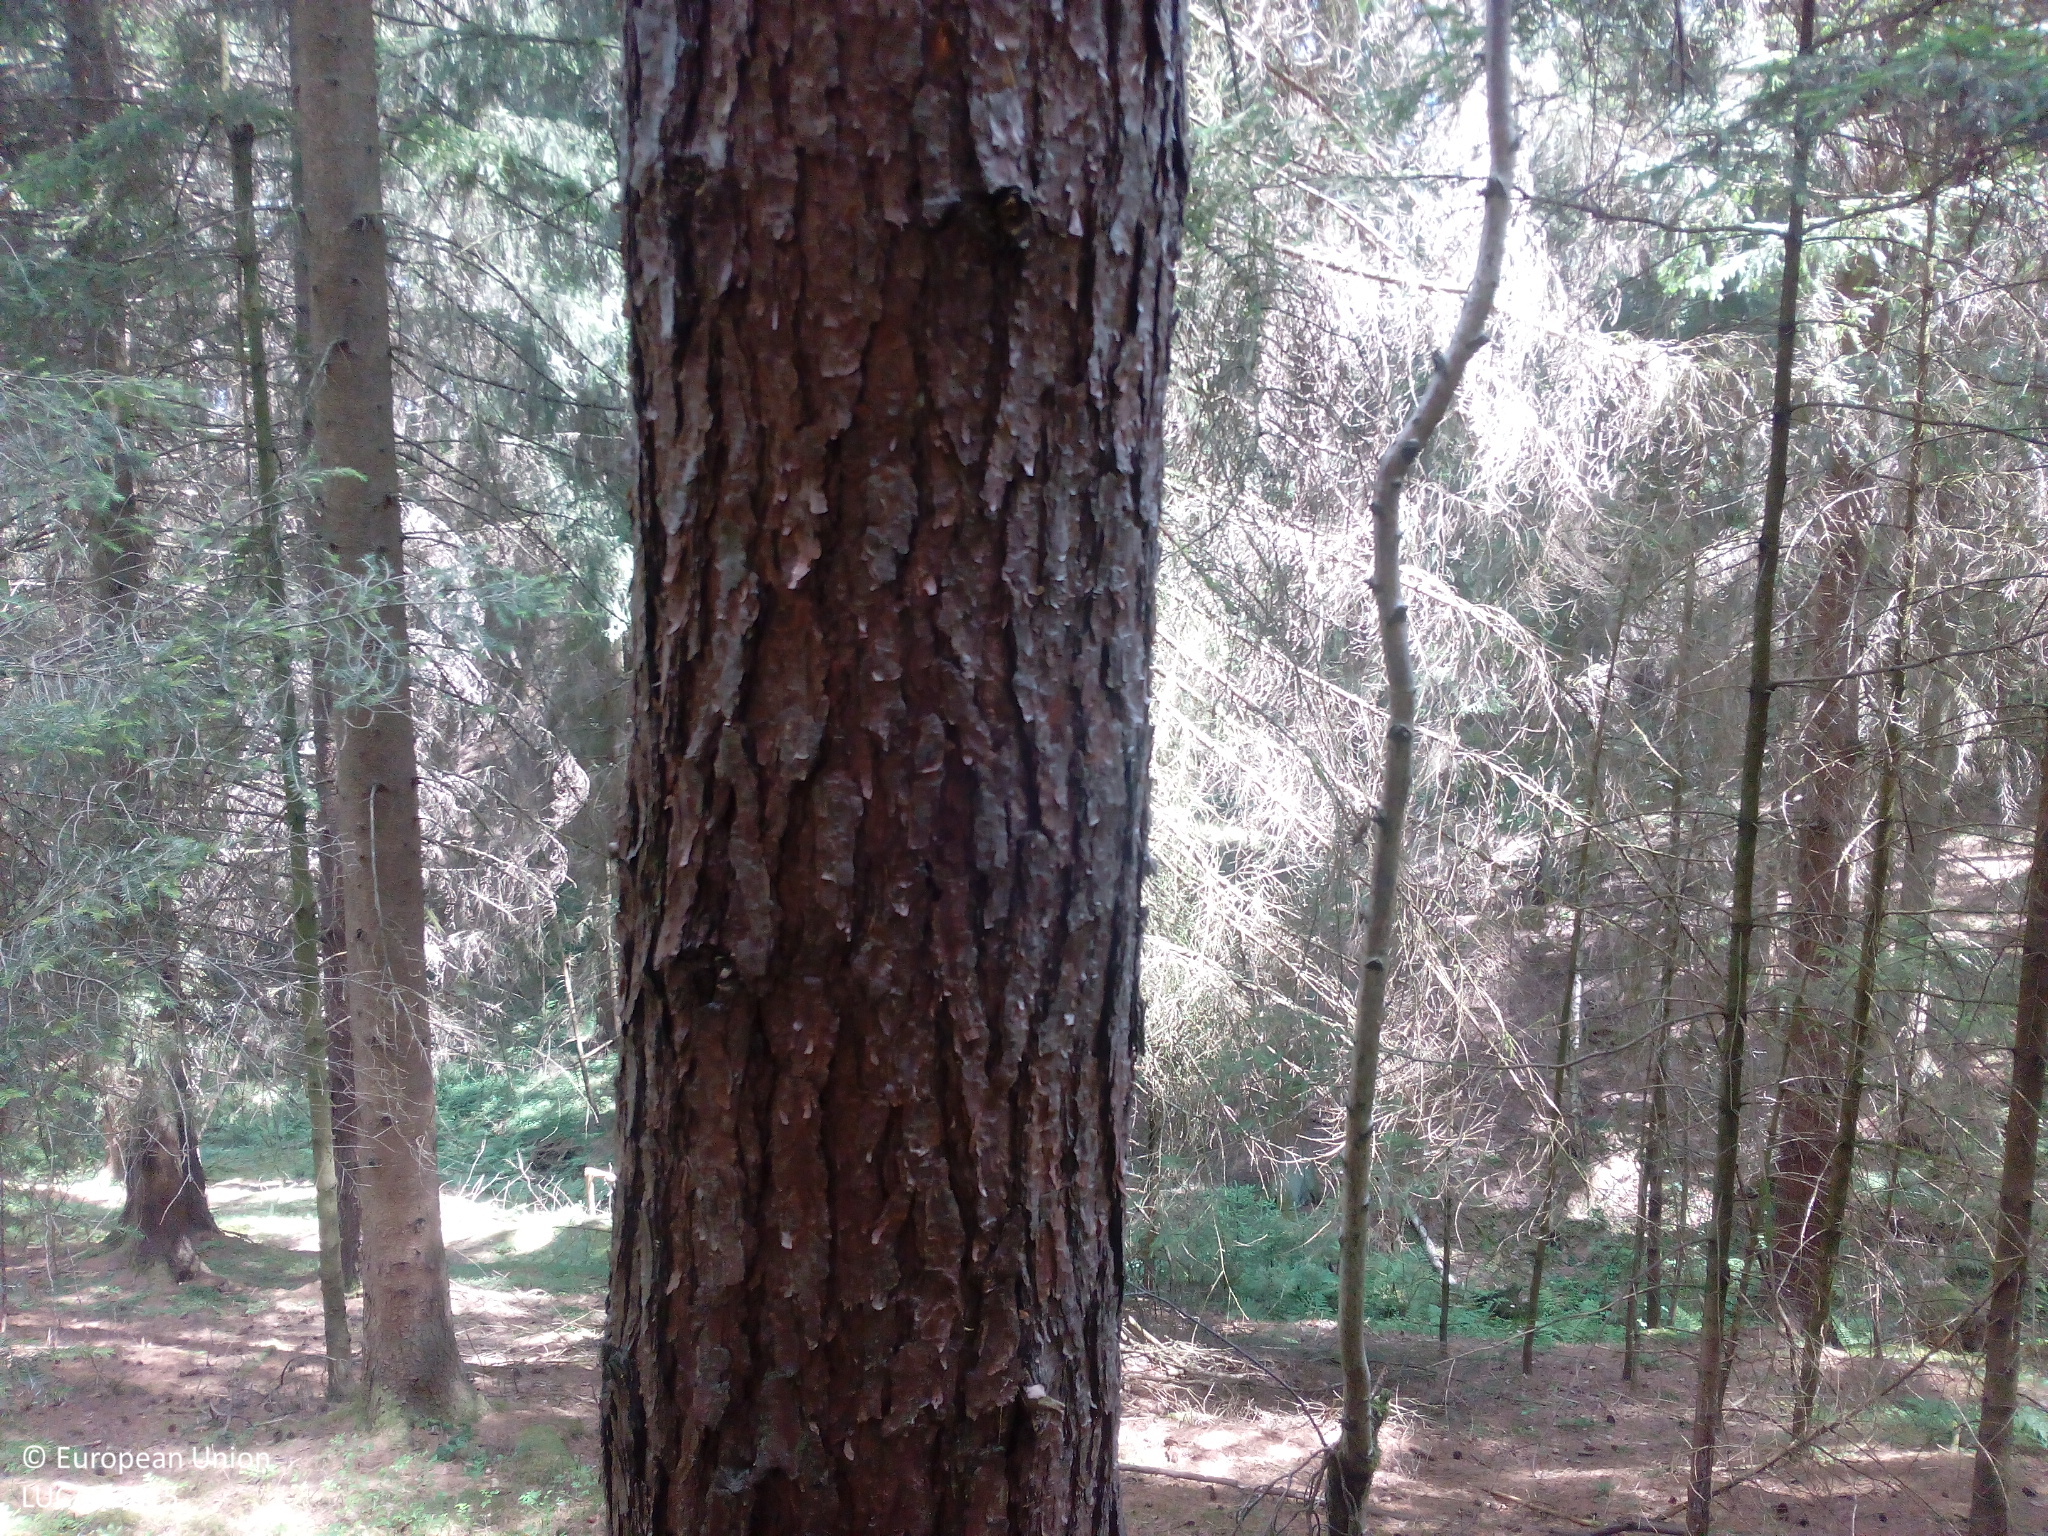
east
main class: Woodland
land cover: Spruce dominated coniferous woodland
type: hemiboreal forest and nemoral coniferous forest and mixed broadleaved-coniferous forest
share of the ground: > 75 %
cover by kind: coniferous forest trees 80 %, unconsolidated bare surface 10 %, shrubs 5 %, lichens and mosses 5 %
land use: Forestry
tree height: > 5 m
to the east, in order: Spruce dominated coniferous woodland; Rivers and streams; Spruce dominated coniferous woodland; Broadleaved woodland; Grass margins; Paved roads, cycling and walking lanes; Grass margins; Ditches and canals; Shrubland without tree cover; Grassland without tree/shrub cover; Fences; Broadleaved woodland; Spruce dominated mixed woodland; Fences; Spruce dominated coniferous woodland
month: July
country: DE
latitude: 49.5868
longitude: 12.2266
